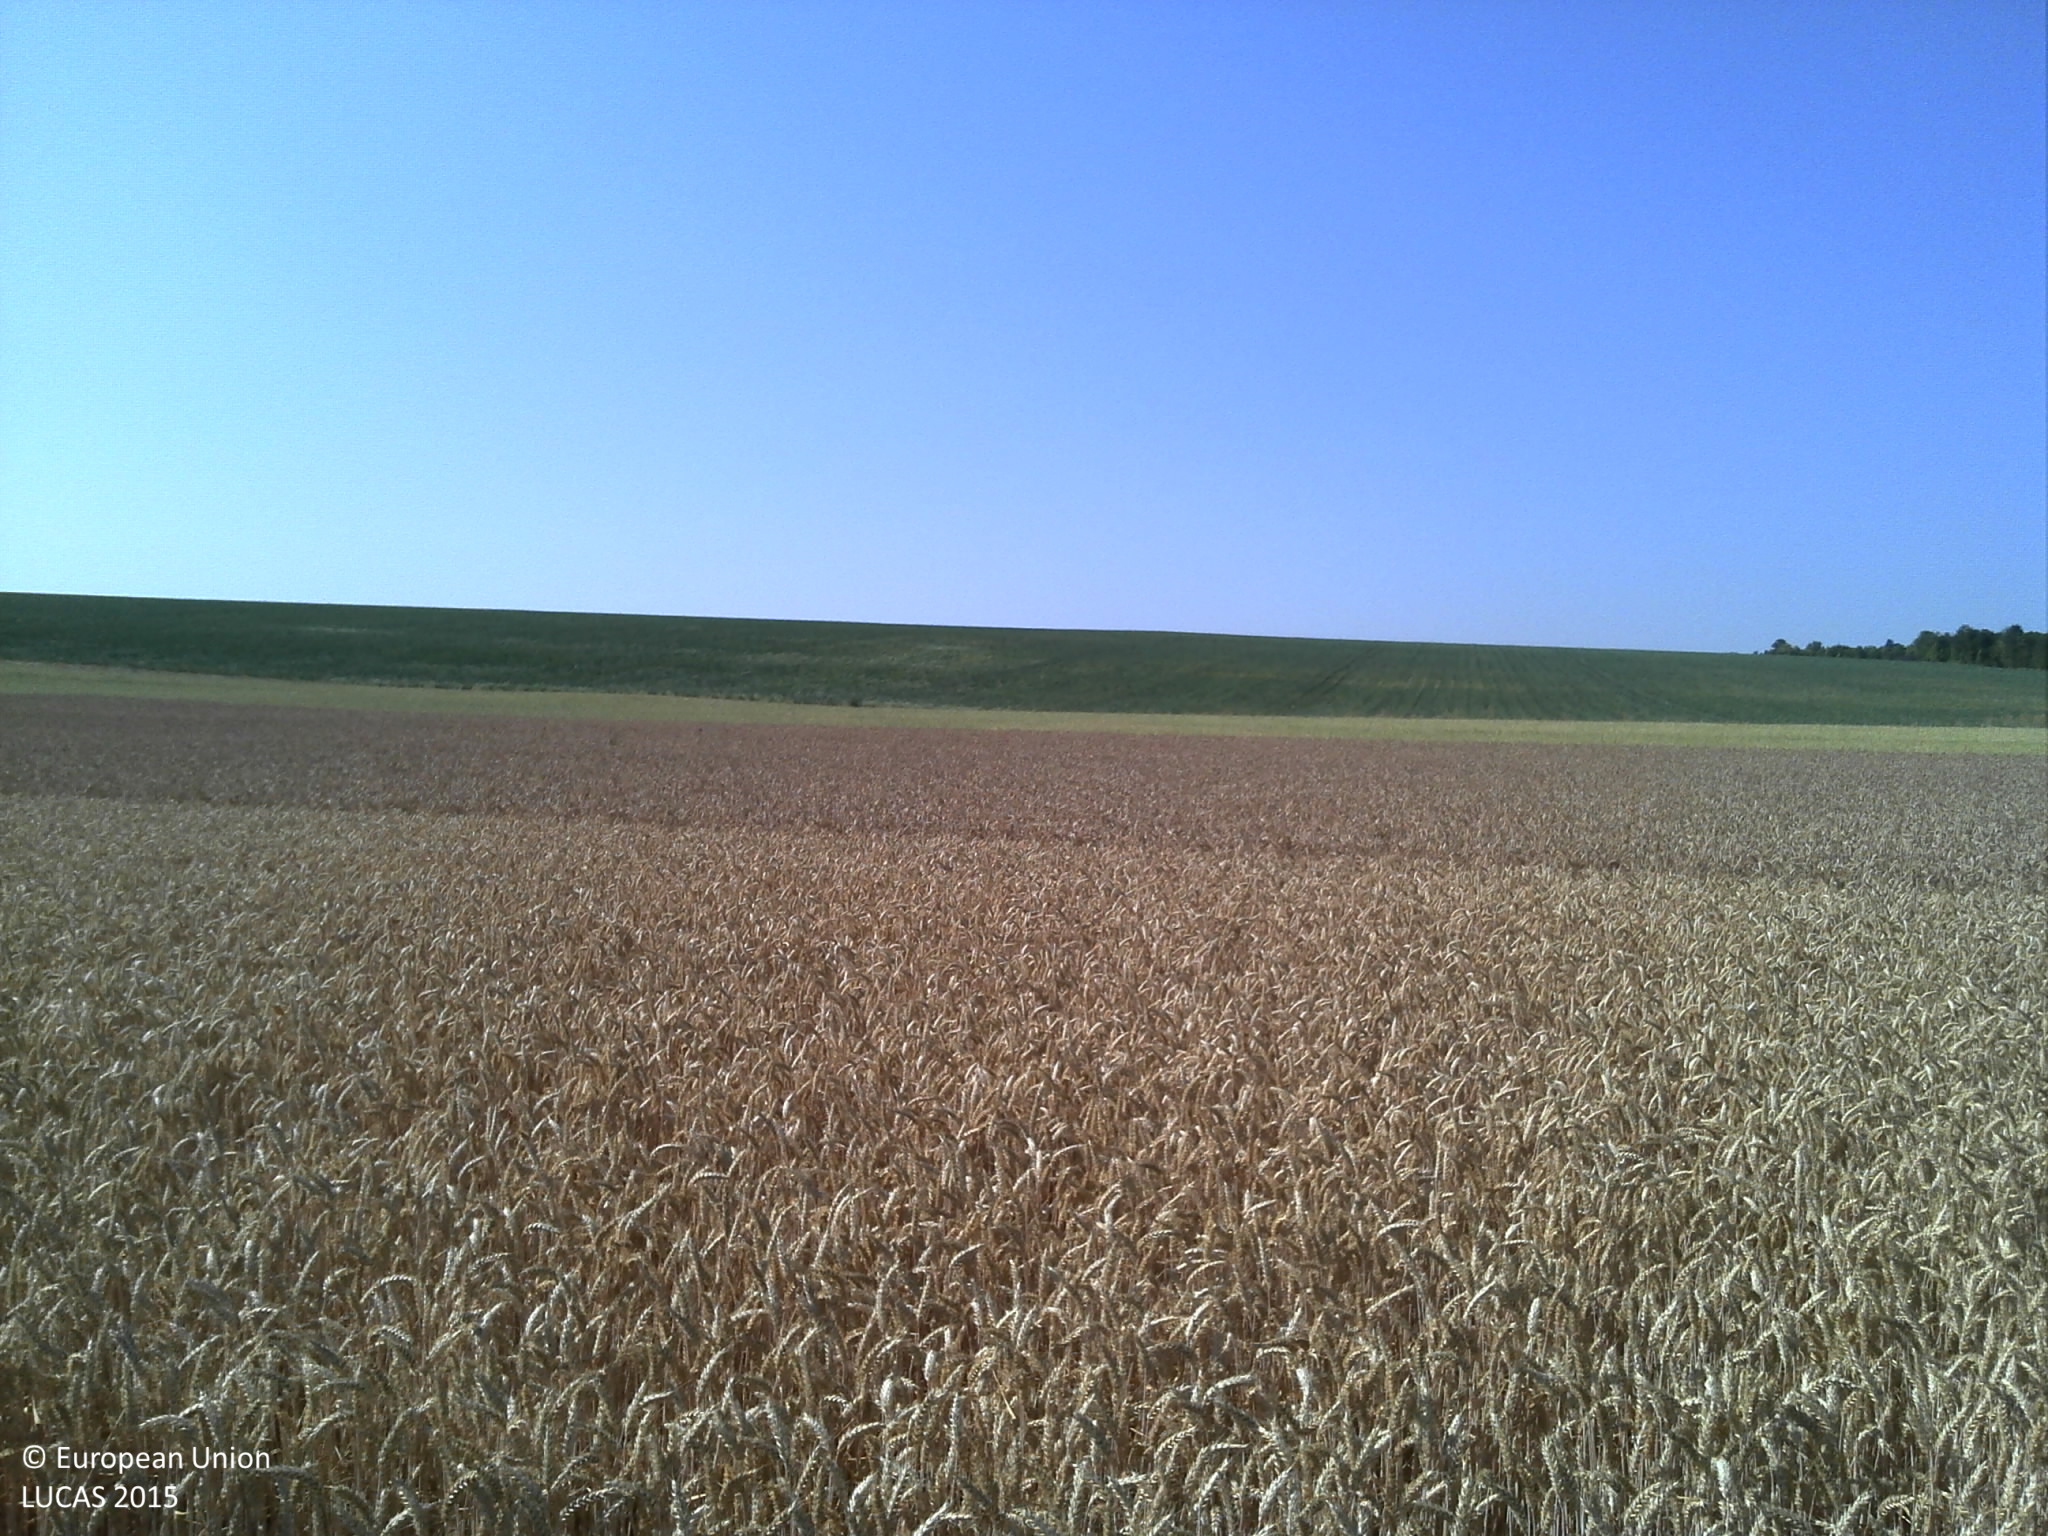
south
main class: Cropland
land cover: Common wheat
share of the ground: > 75 %
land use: Agriculture (excluding fallow land and kitchen gardens)
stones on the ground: < 10 %
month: July
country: FR
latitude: 49.4217
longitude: 4.1638
